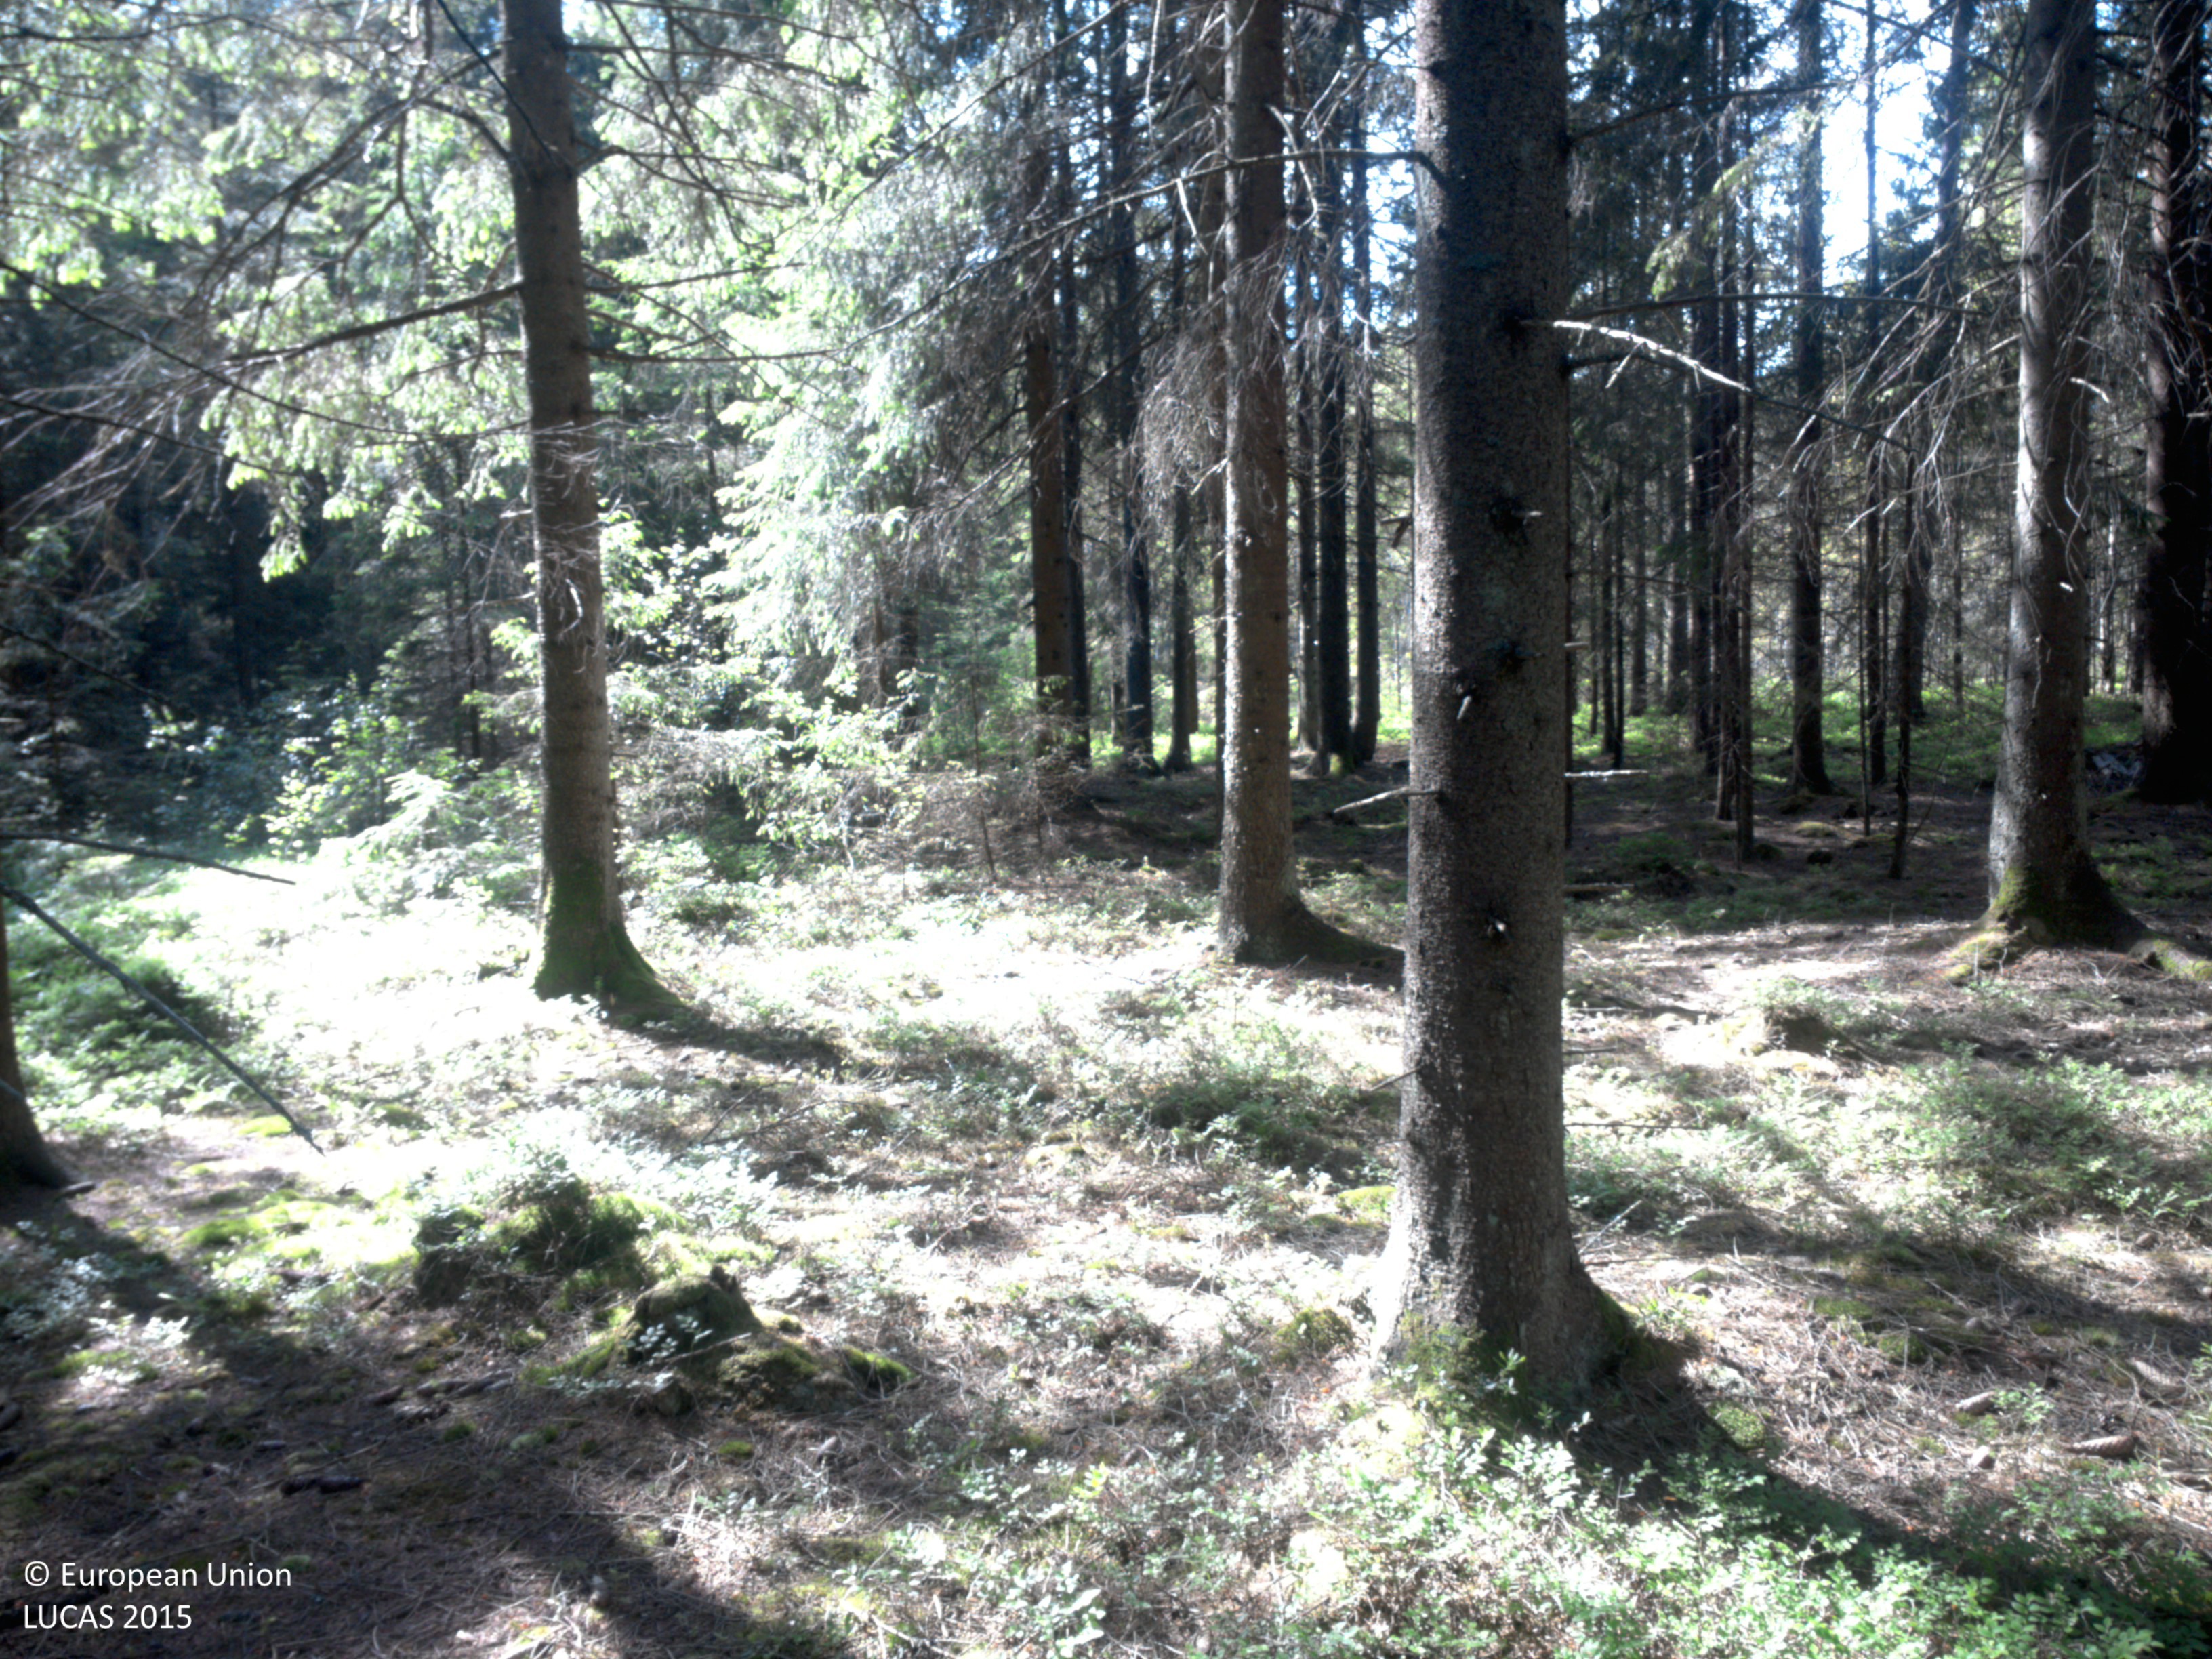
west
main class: Woodland
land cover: Spruce dominated coniferous woodland
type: boreal forest
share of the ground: 50 - 75 %
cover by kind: coniferous forest trees 55 %, shrubs 25 %, herbaceous plants 10 %, broadleaved forest trees 5 %, lichens and mosses 5 %
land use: Forestry
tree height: > 5 m
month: June
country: SE
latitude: 58.5514
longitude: 11.6290
